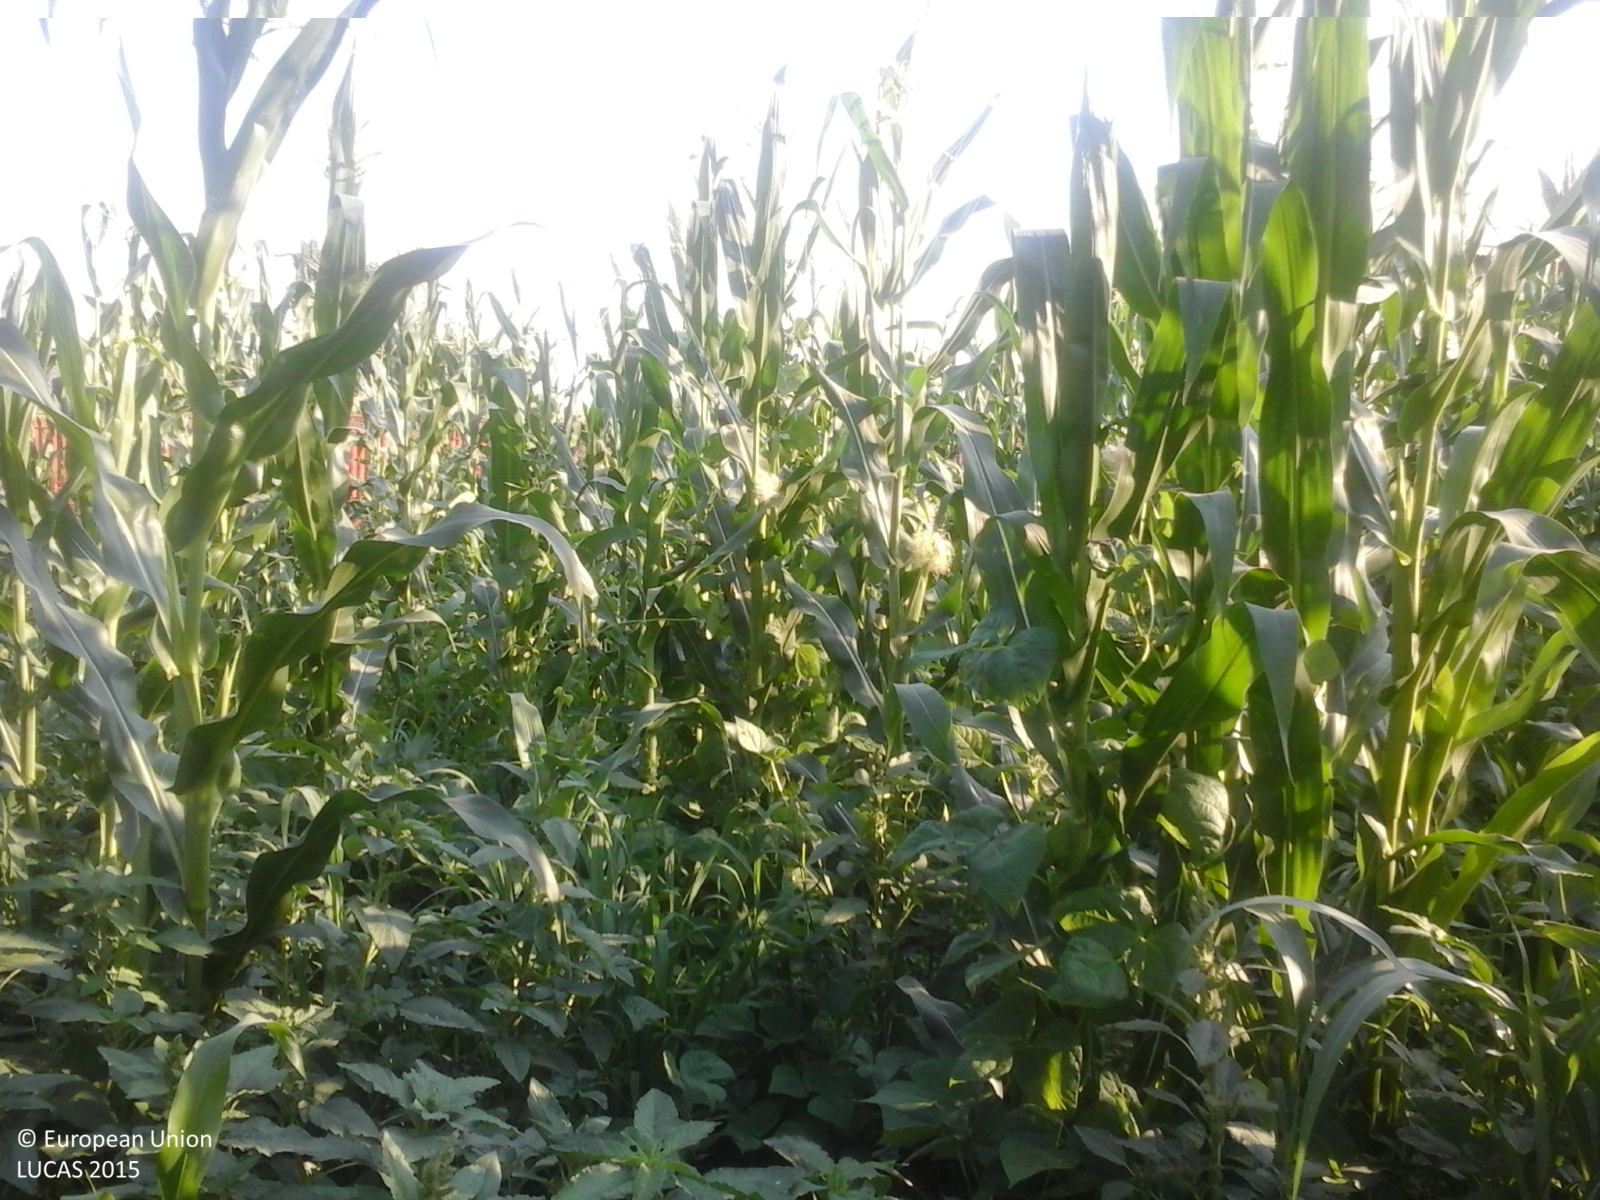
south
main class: Cropland
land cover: Maize
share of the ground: > 75 %
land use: Agriculture (excluding fallow land and kitchen gardens)
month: July
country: RO
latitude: 44.6073
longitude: 25.5028
